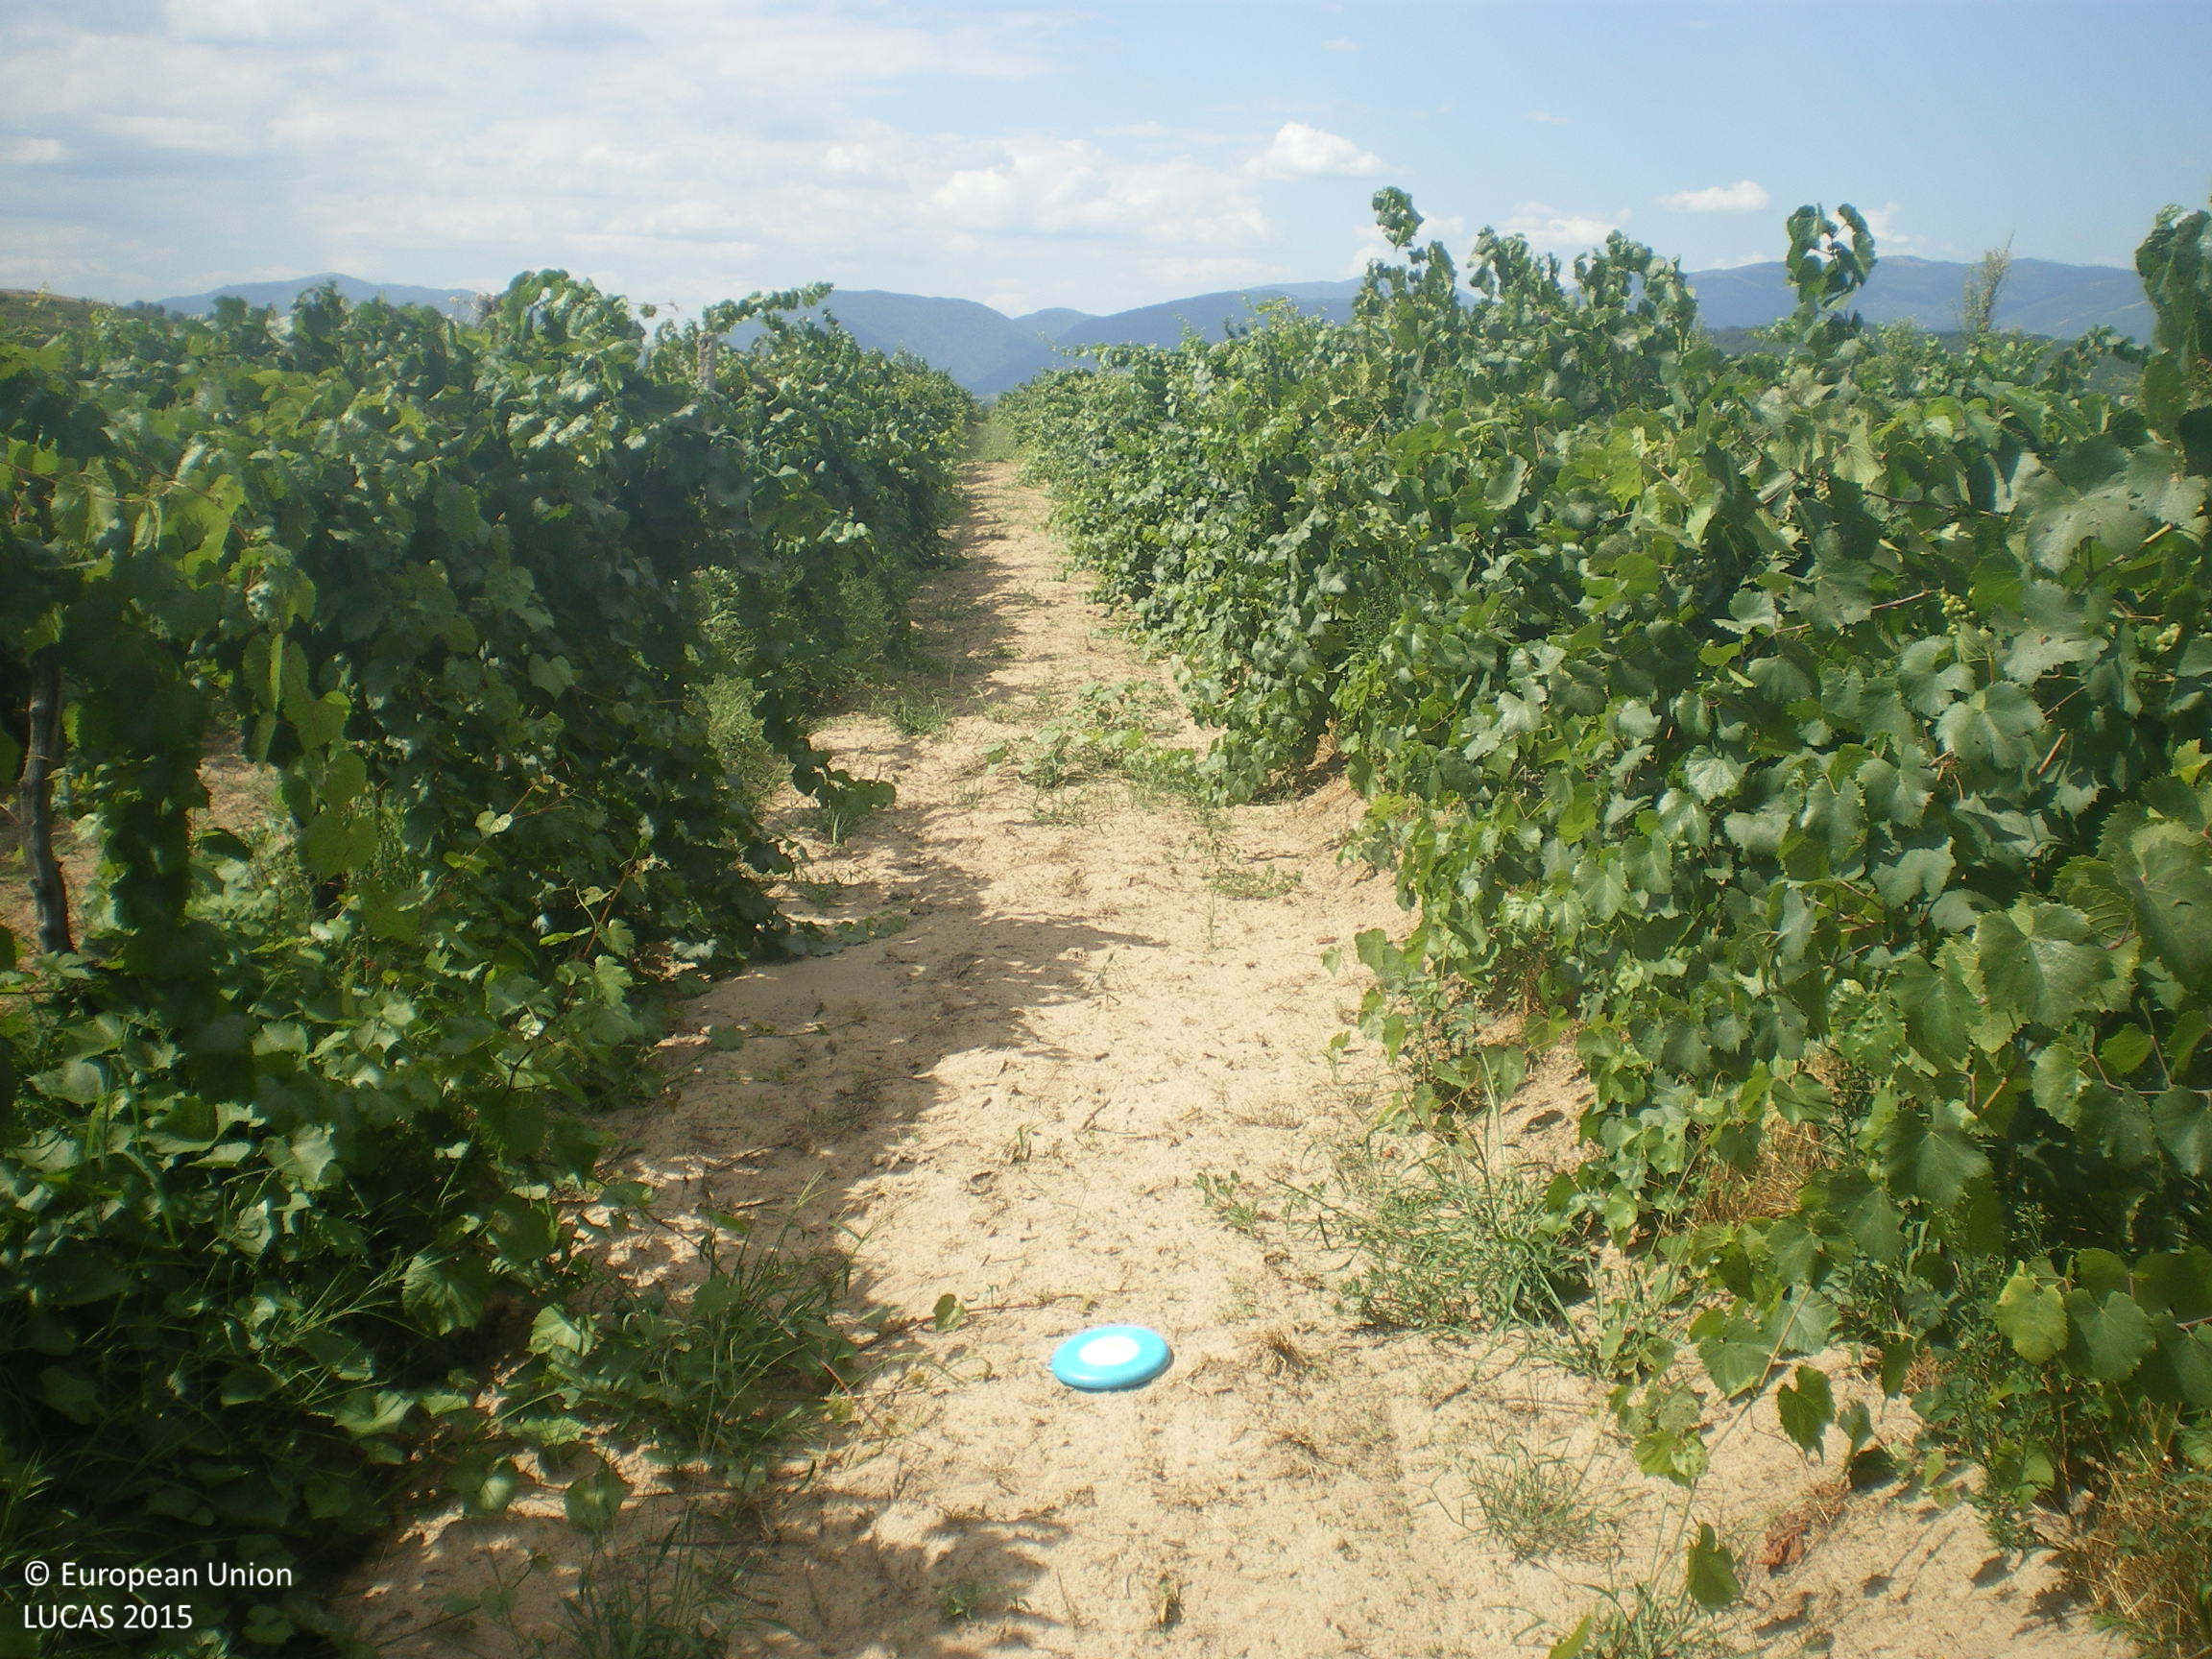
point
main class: Cropland
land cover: Vineyards
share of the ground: 50 - 75 %
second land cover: Other bare soil
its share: > 75 %
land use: Agriculture (excluding fallow land and kitchen gardens)
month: August
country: BG
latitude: 42.6105
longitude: 25.8404
